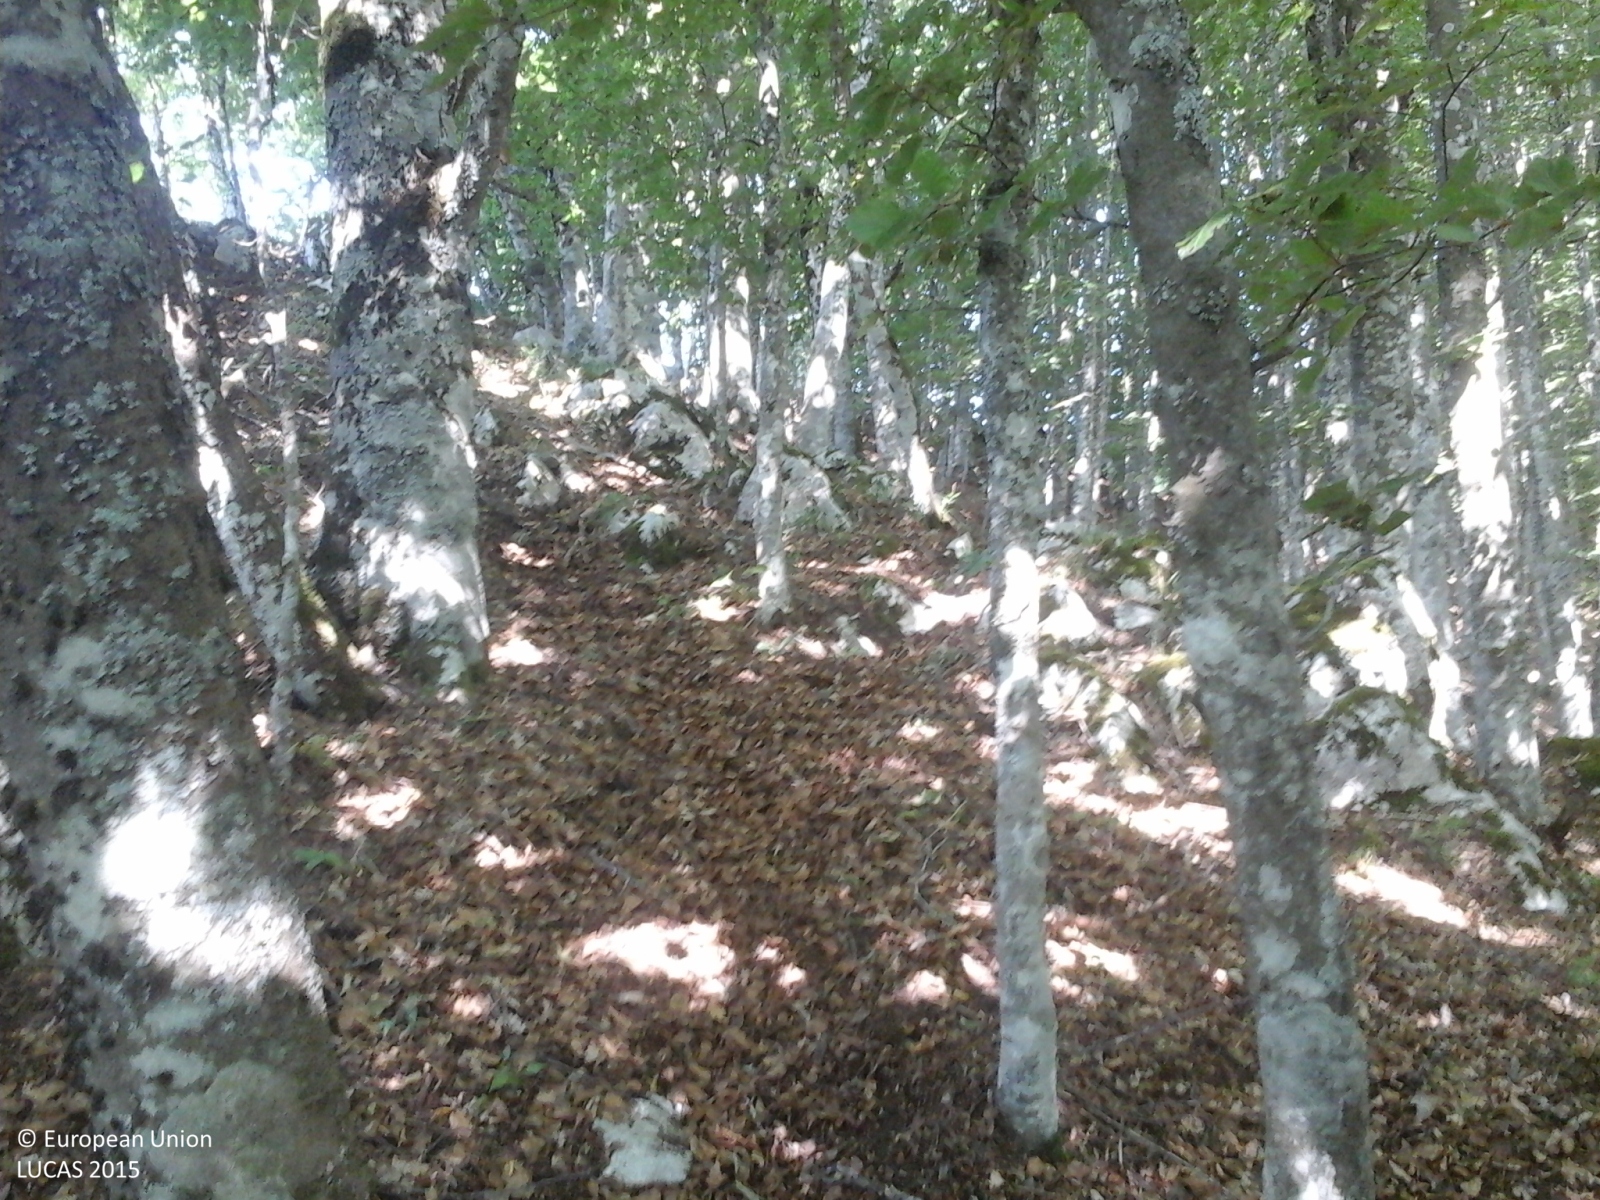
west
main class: Woodland
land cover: Broadleaved woodland
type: mountainous beech forest
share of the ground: > 75 %
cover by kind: broadleaved forest trees 95 %, herbaceous plants 5 %
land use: Semi-natural and natural areas not in use
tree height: > 5 m
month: July
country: IT
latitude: 40.8131
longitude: 14.9475
